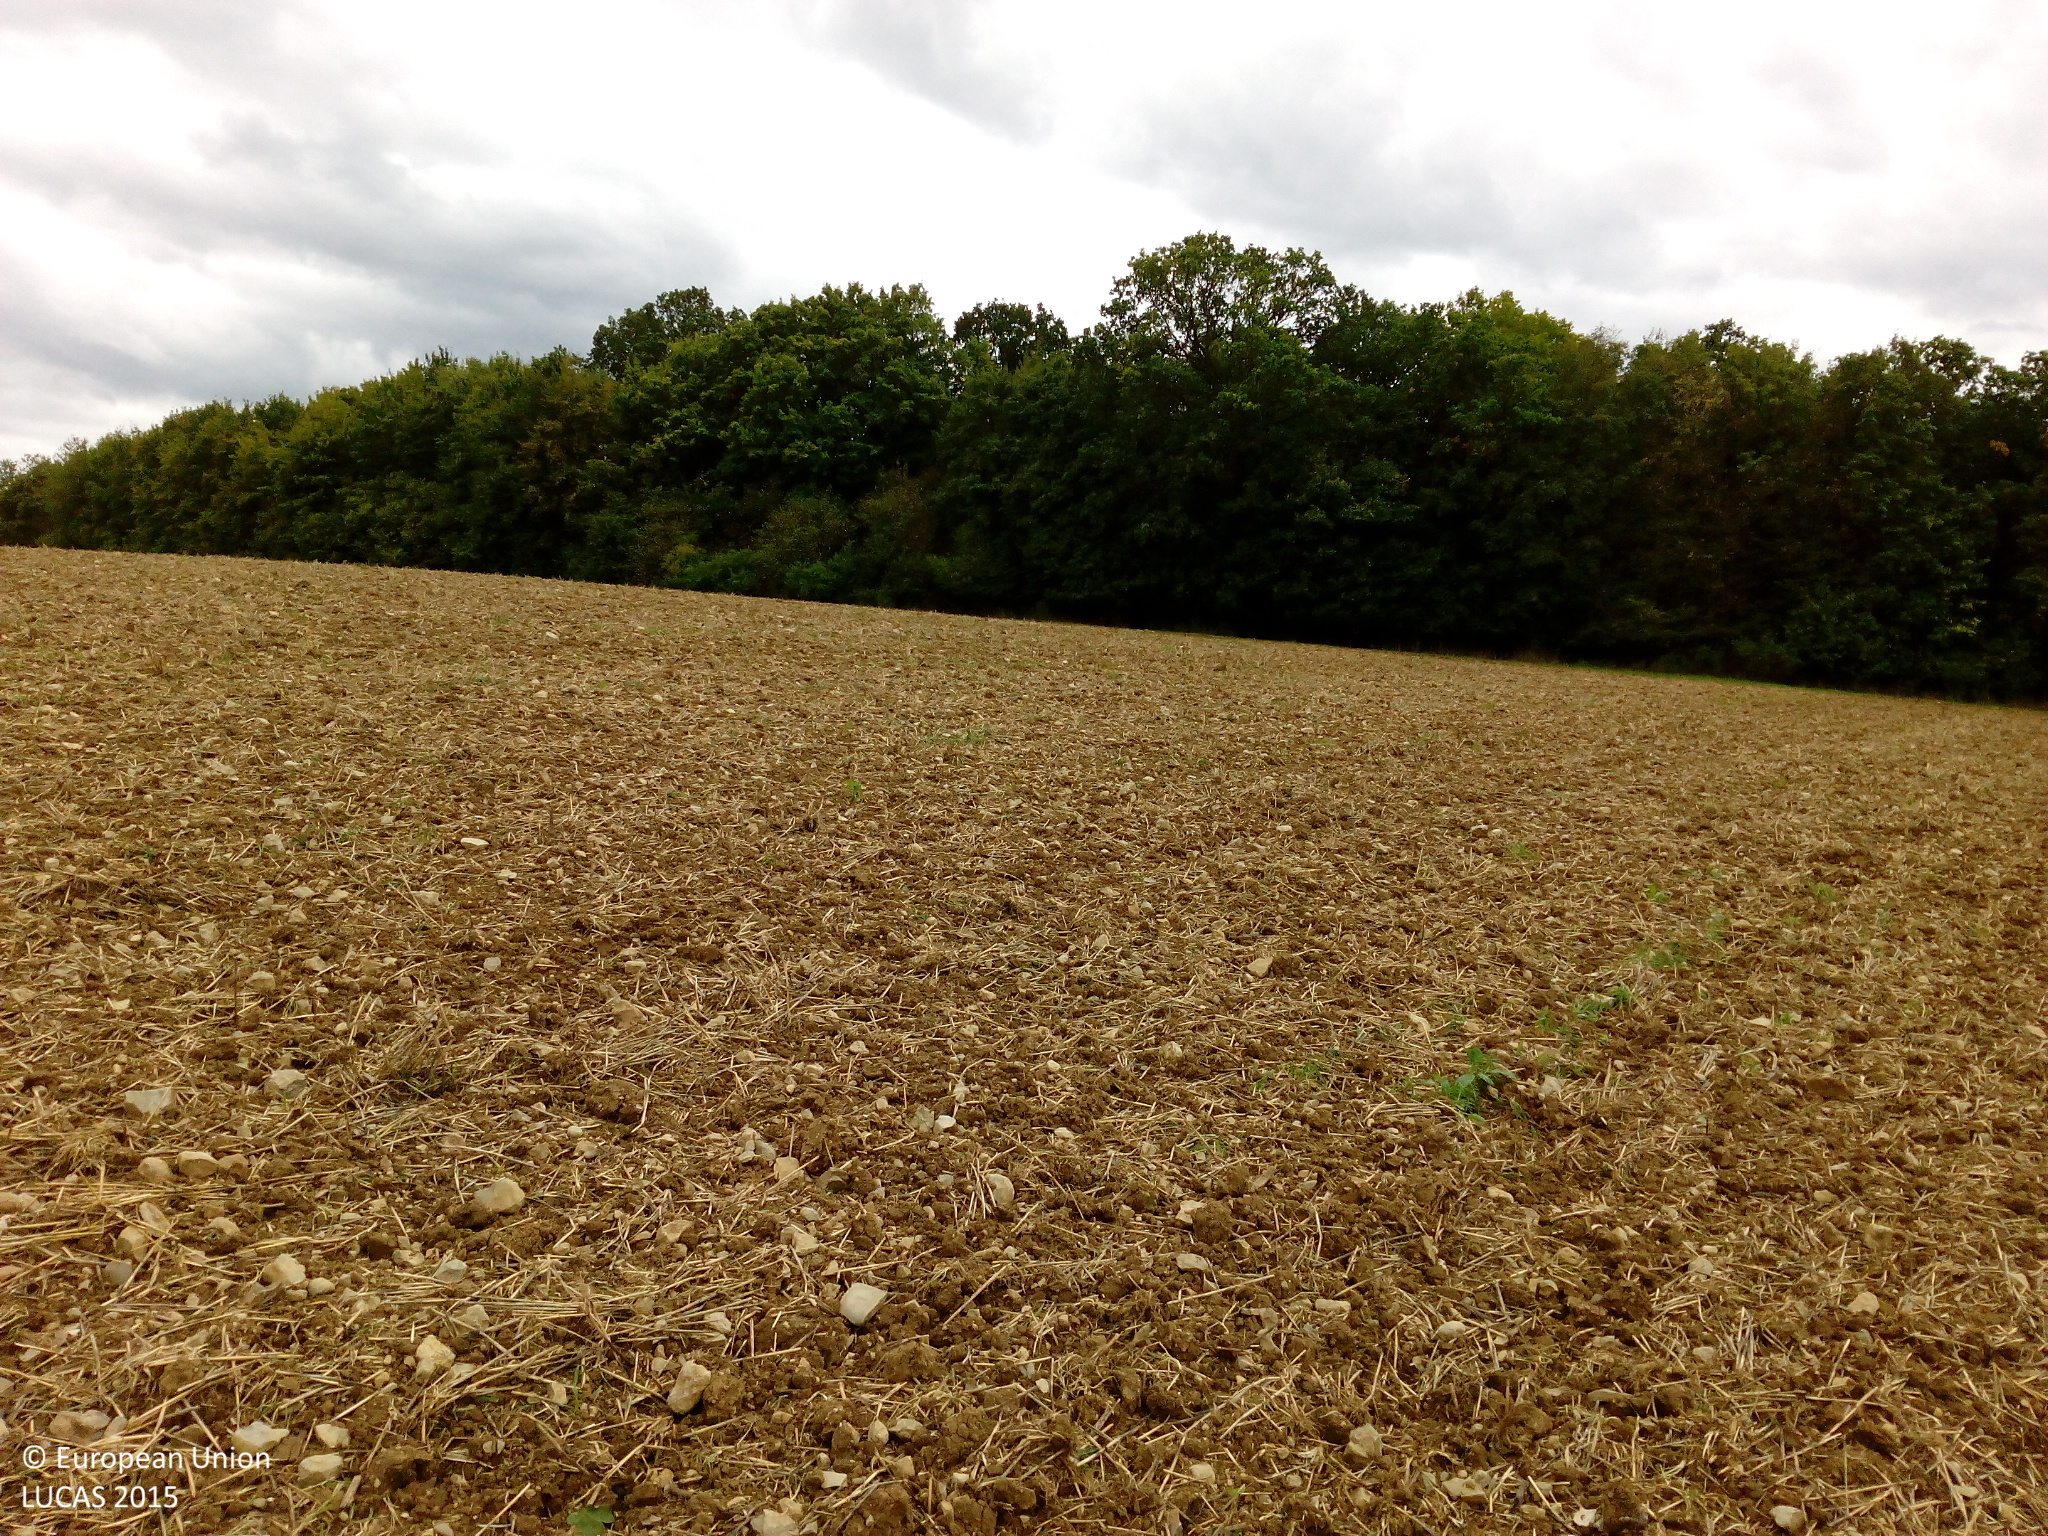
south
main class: Cropland
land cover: Common wheat
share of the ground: 10 - 25 %
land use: Agriculture (excluding fallow land and kitchen gardens)
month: September
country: DE
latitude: 49.9864
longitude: 9.9303
